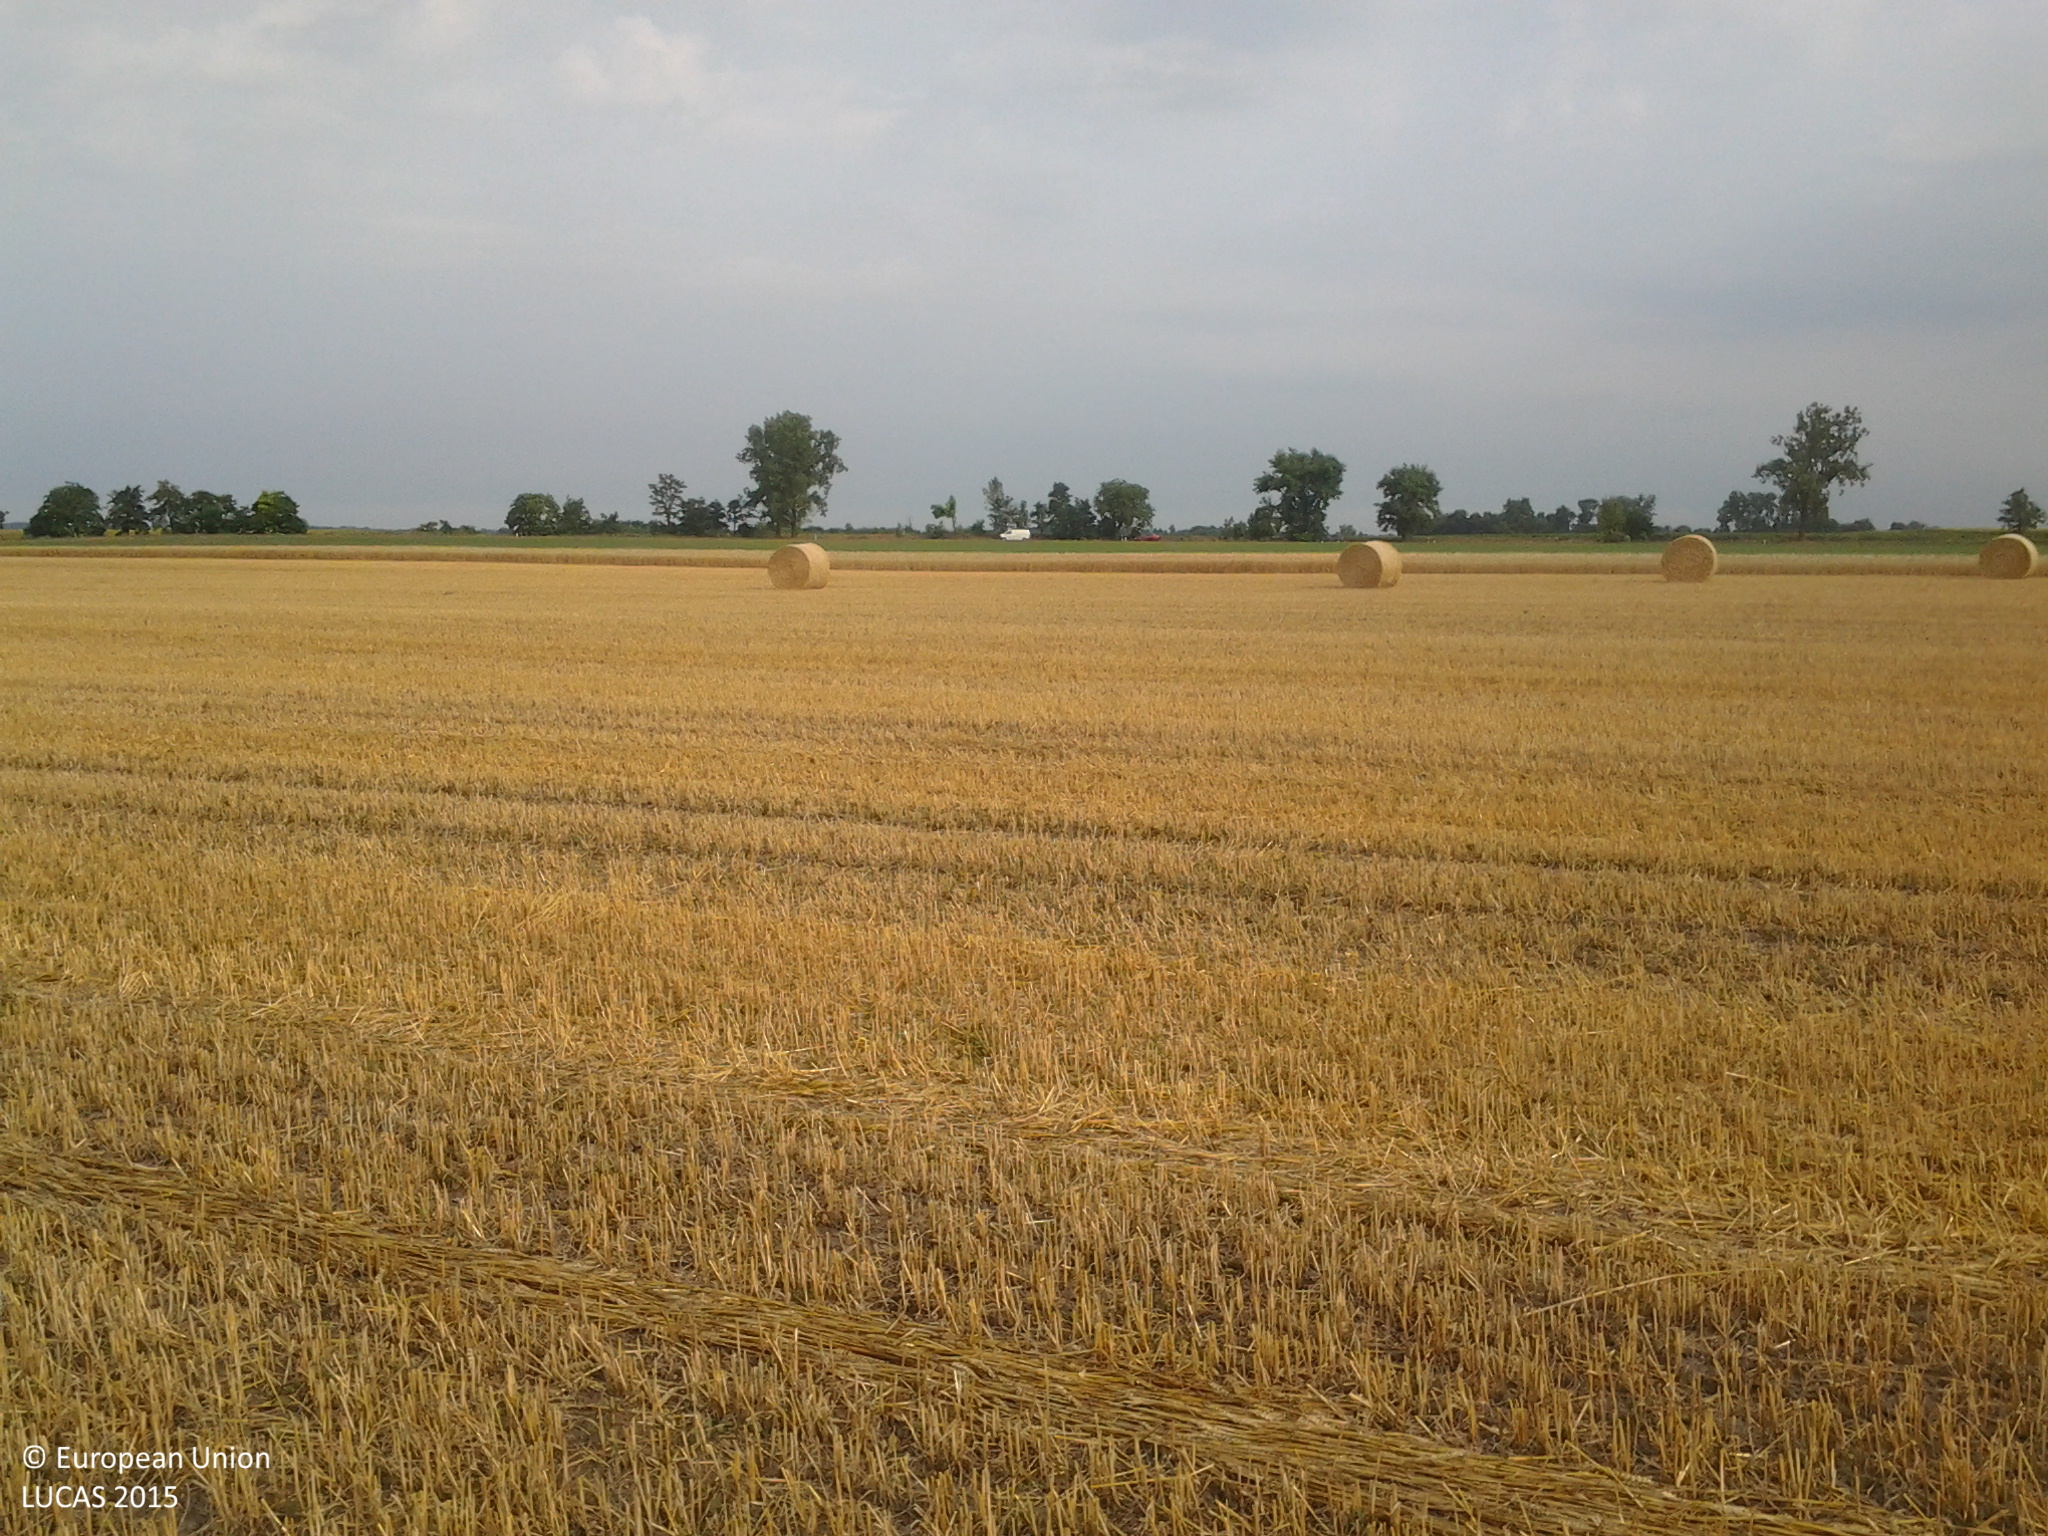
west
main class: Cropland
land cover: Common wheat
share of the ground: 25 - 50 %
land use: Agriculture (excluding fallow land and kitchen gardens)
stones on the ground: < 10 %
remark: Harvested field
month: July
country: HU
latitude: 46.9681
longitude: 18.9923
